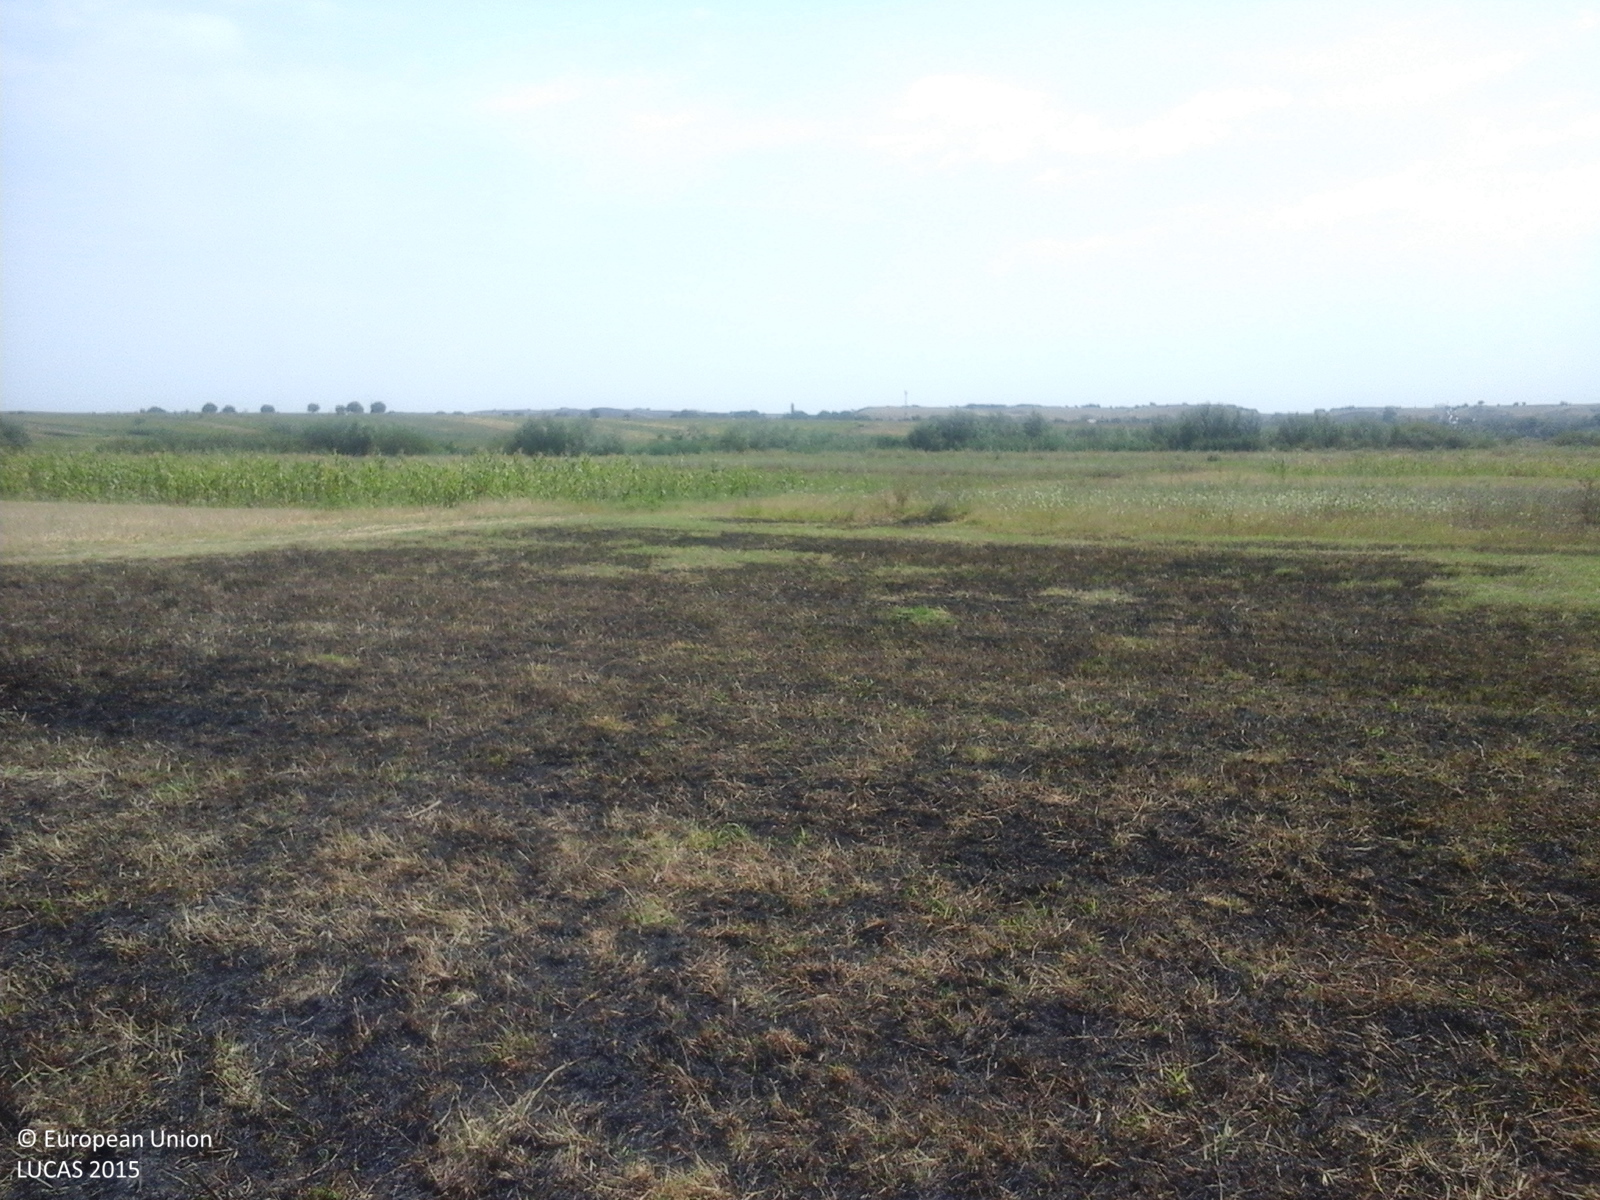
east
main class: Cropland
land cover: Barley
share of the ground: < 10 %
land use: Agriculture (excluding fallow land and kitchen gardens)
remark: Burnt area
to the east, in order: Barley; Grass margins; Tracks; Grass margins; Maize; Spontaneously vegetated surfaces; Inland fresh running water; Inland marshes; Abandoned hedges; Maize; Arable land (only in case pi)
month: August
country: RO
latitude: 44.2464
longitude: 22.9538
